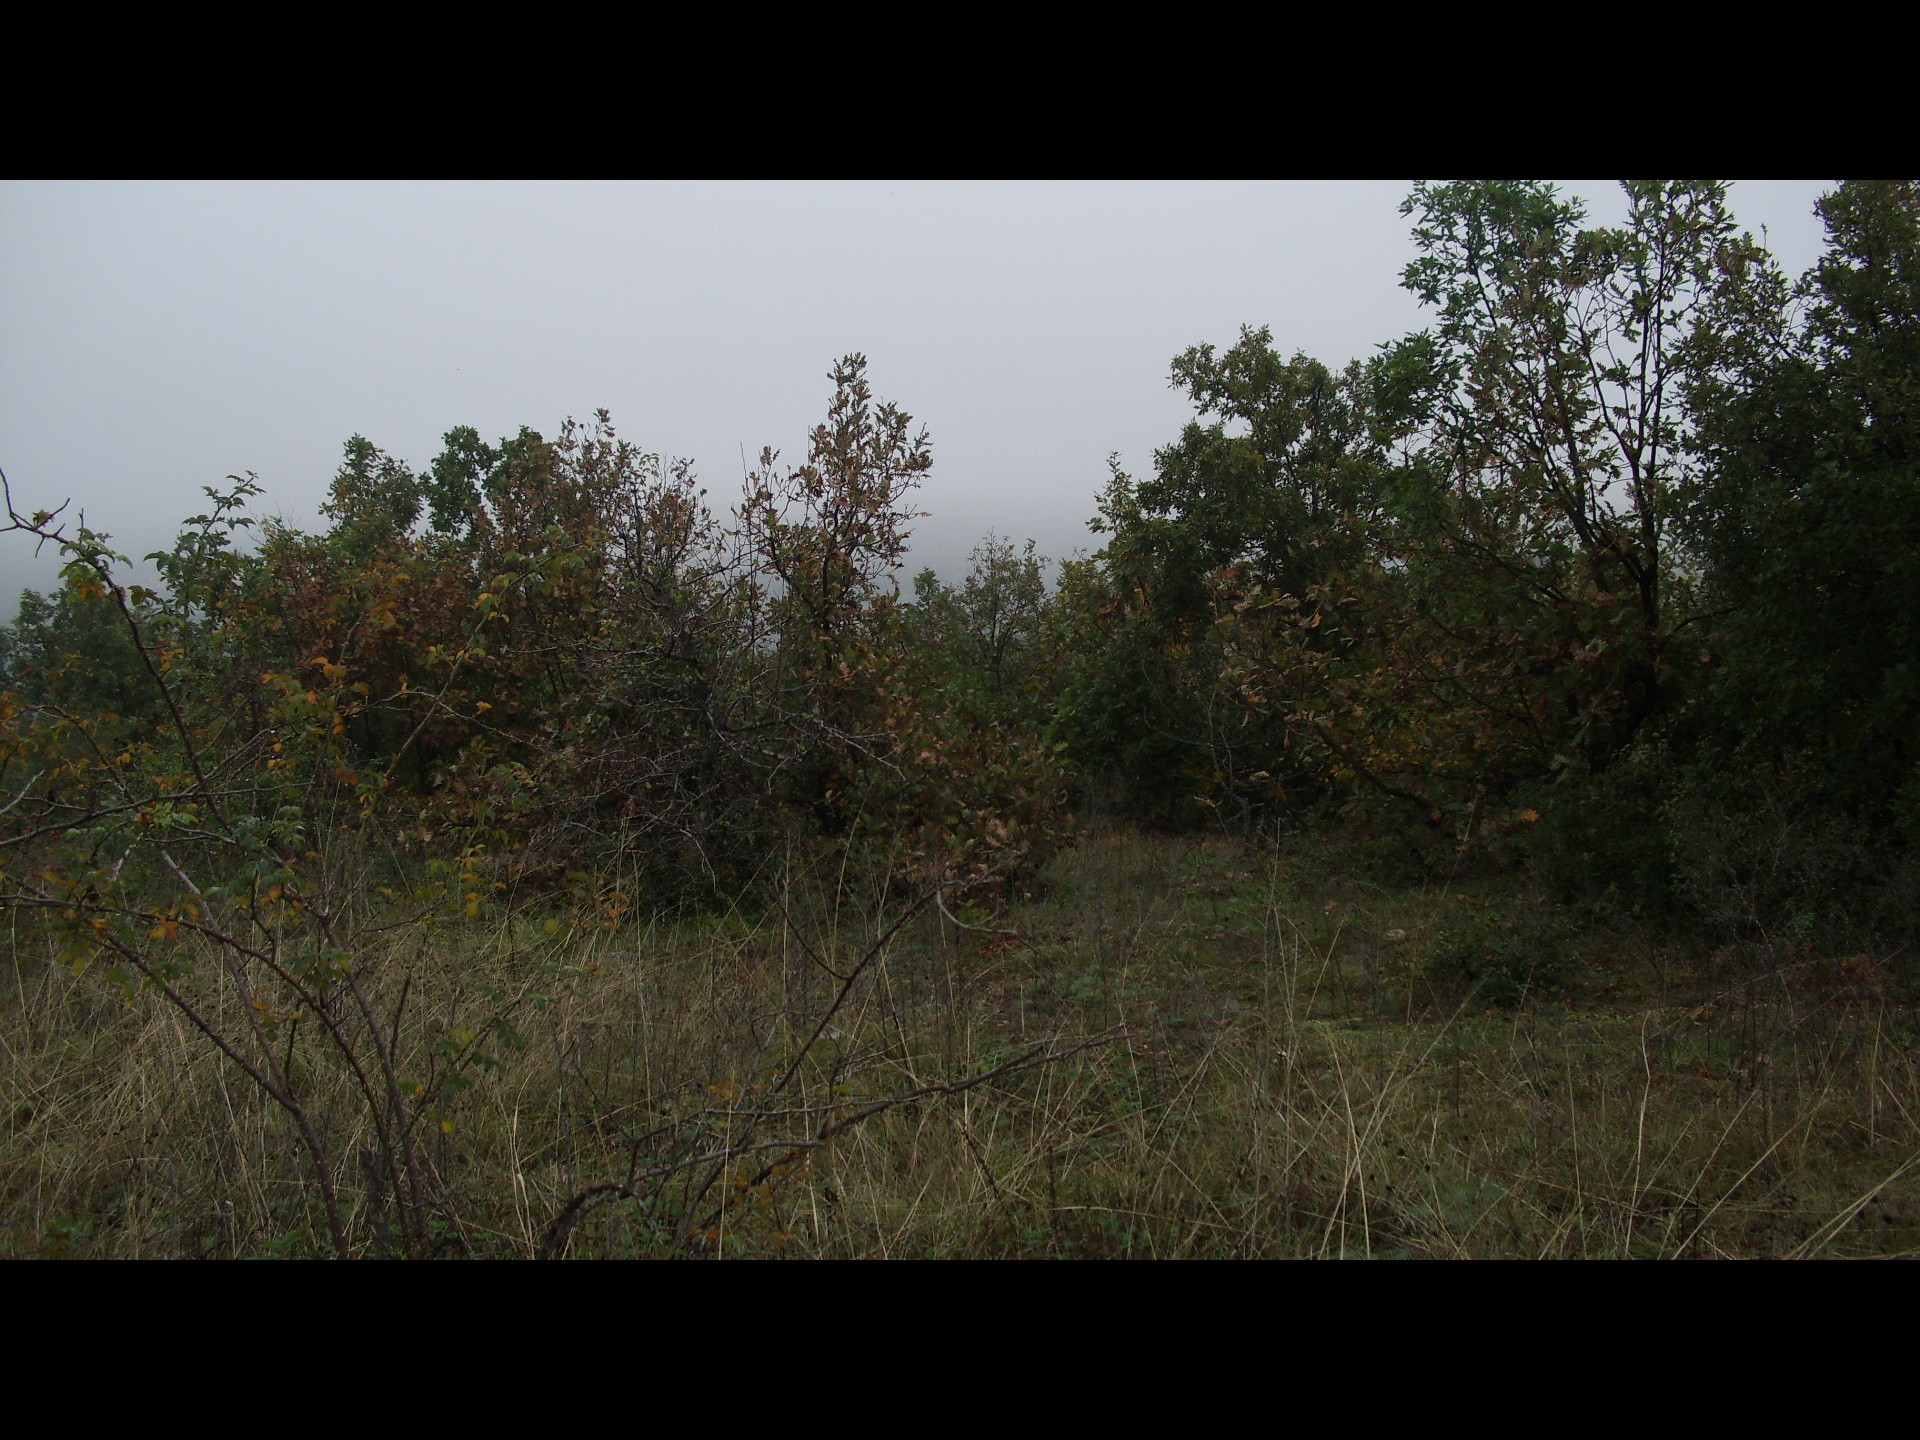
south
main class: Grassland
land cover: Grassland with sparse tree/shrub cover
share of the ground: > 75 %
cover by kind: herbaceous plants 90 %, broadleaved forest trees 5 %, shrubs 5 %
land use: Semi-natural and natural areas not in use
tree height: < 5 m
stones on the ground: < 10 %
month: October
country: BG
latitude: 43.5631
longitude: 22.8744
